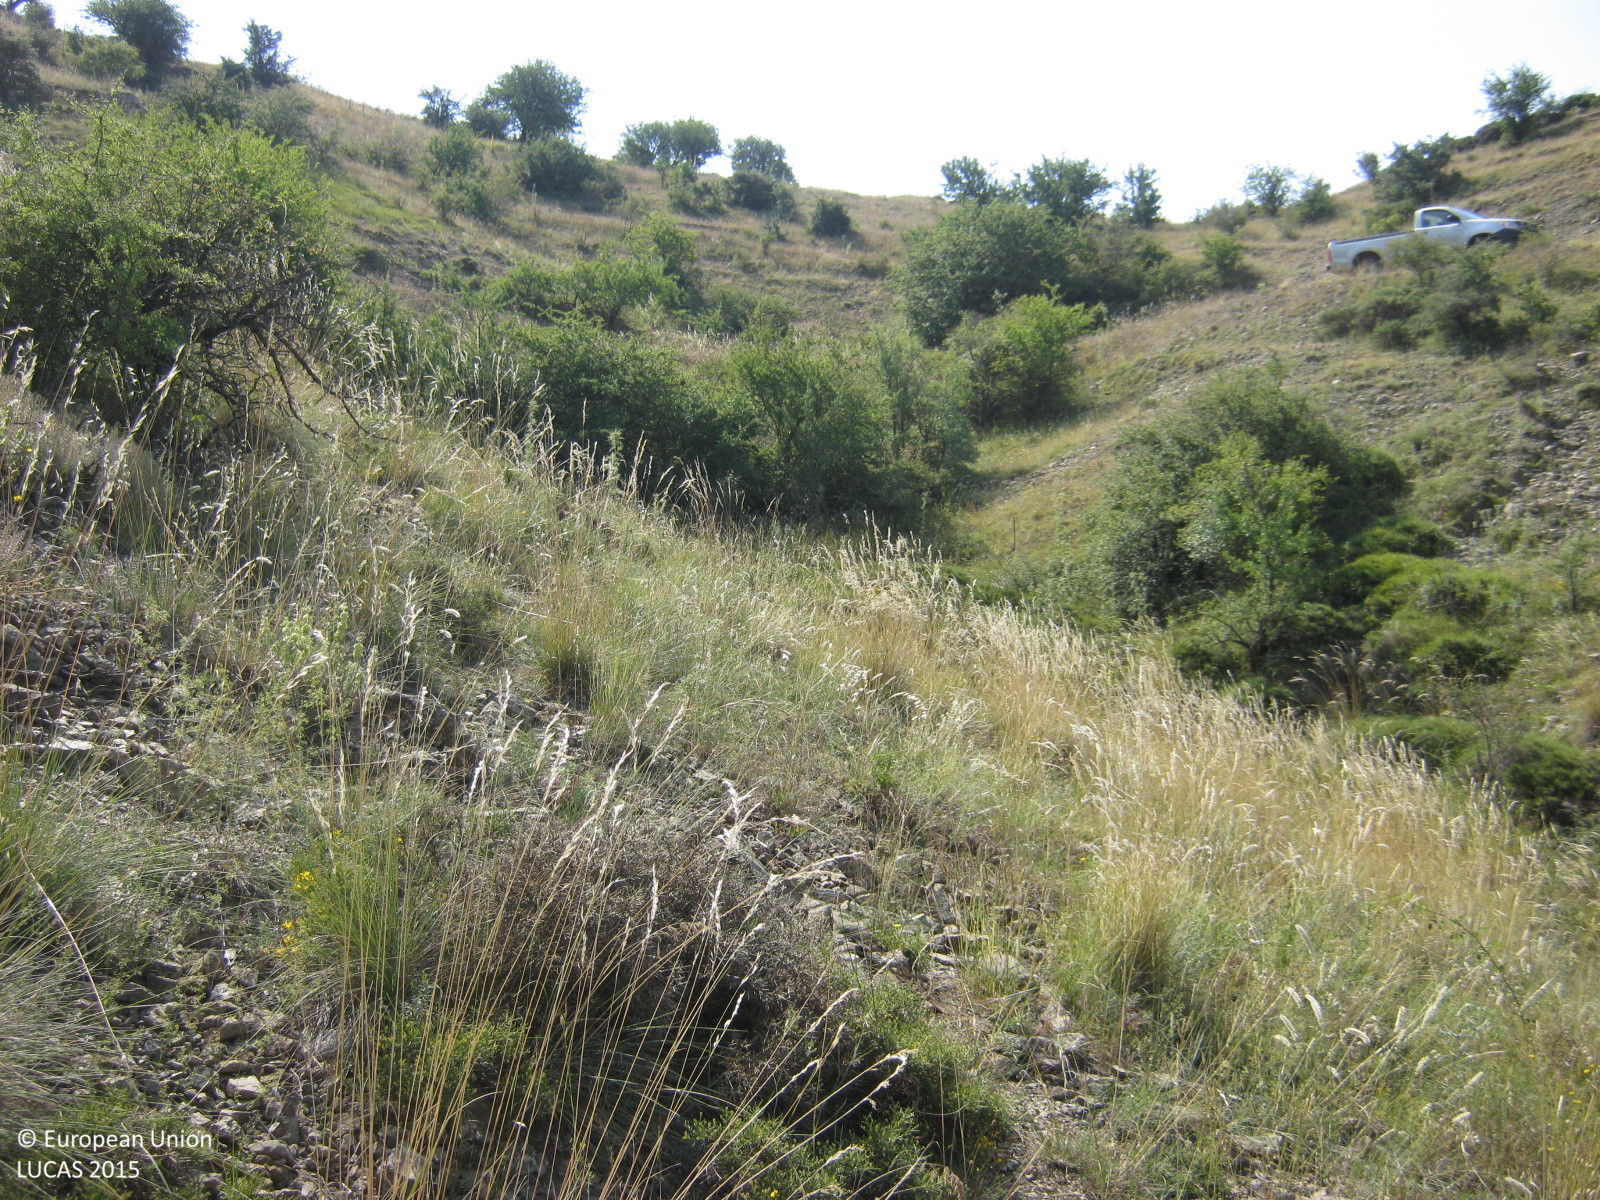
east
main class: Shrubland
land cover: Shrubland without tree cover
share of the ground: 50 - 75 %
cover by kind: shrubs 55 %, unconsolidated bare surface 25 %, herbaceous plants 20 %
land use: Semi-natural and natural areas not in use
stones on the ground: > 50 %
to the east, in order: Shrubland without tree cover; Tracks; Grassland with sparse tree/shrub cover; Shrubland without tree cover; Rocks and stones
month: July
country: GR
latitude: 37.3616
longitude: 22.4819
